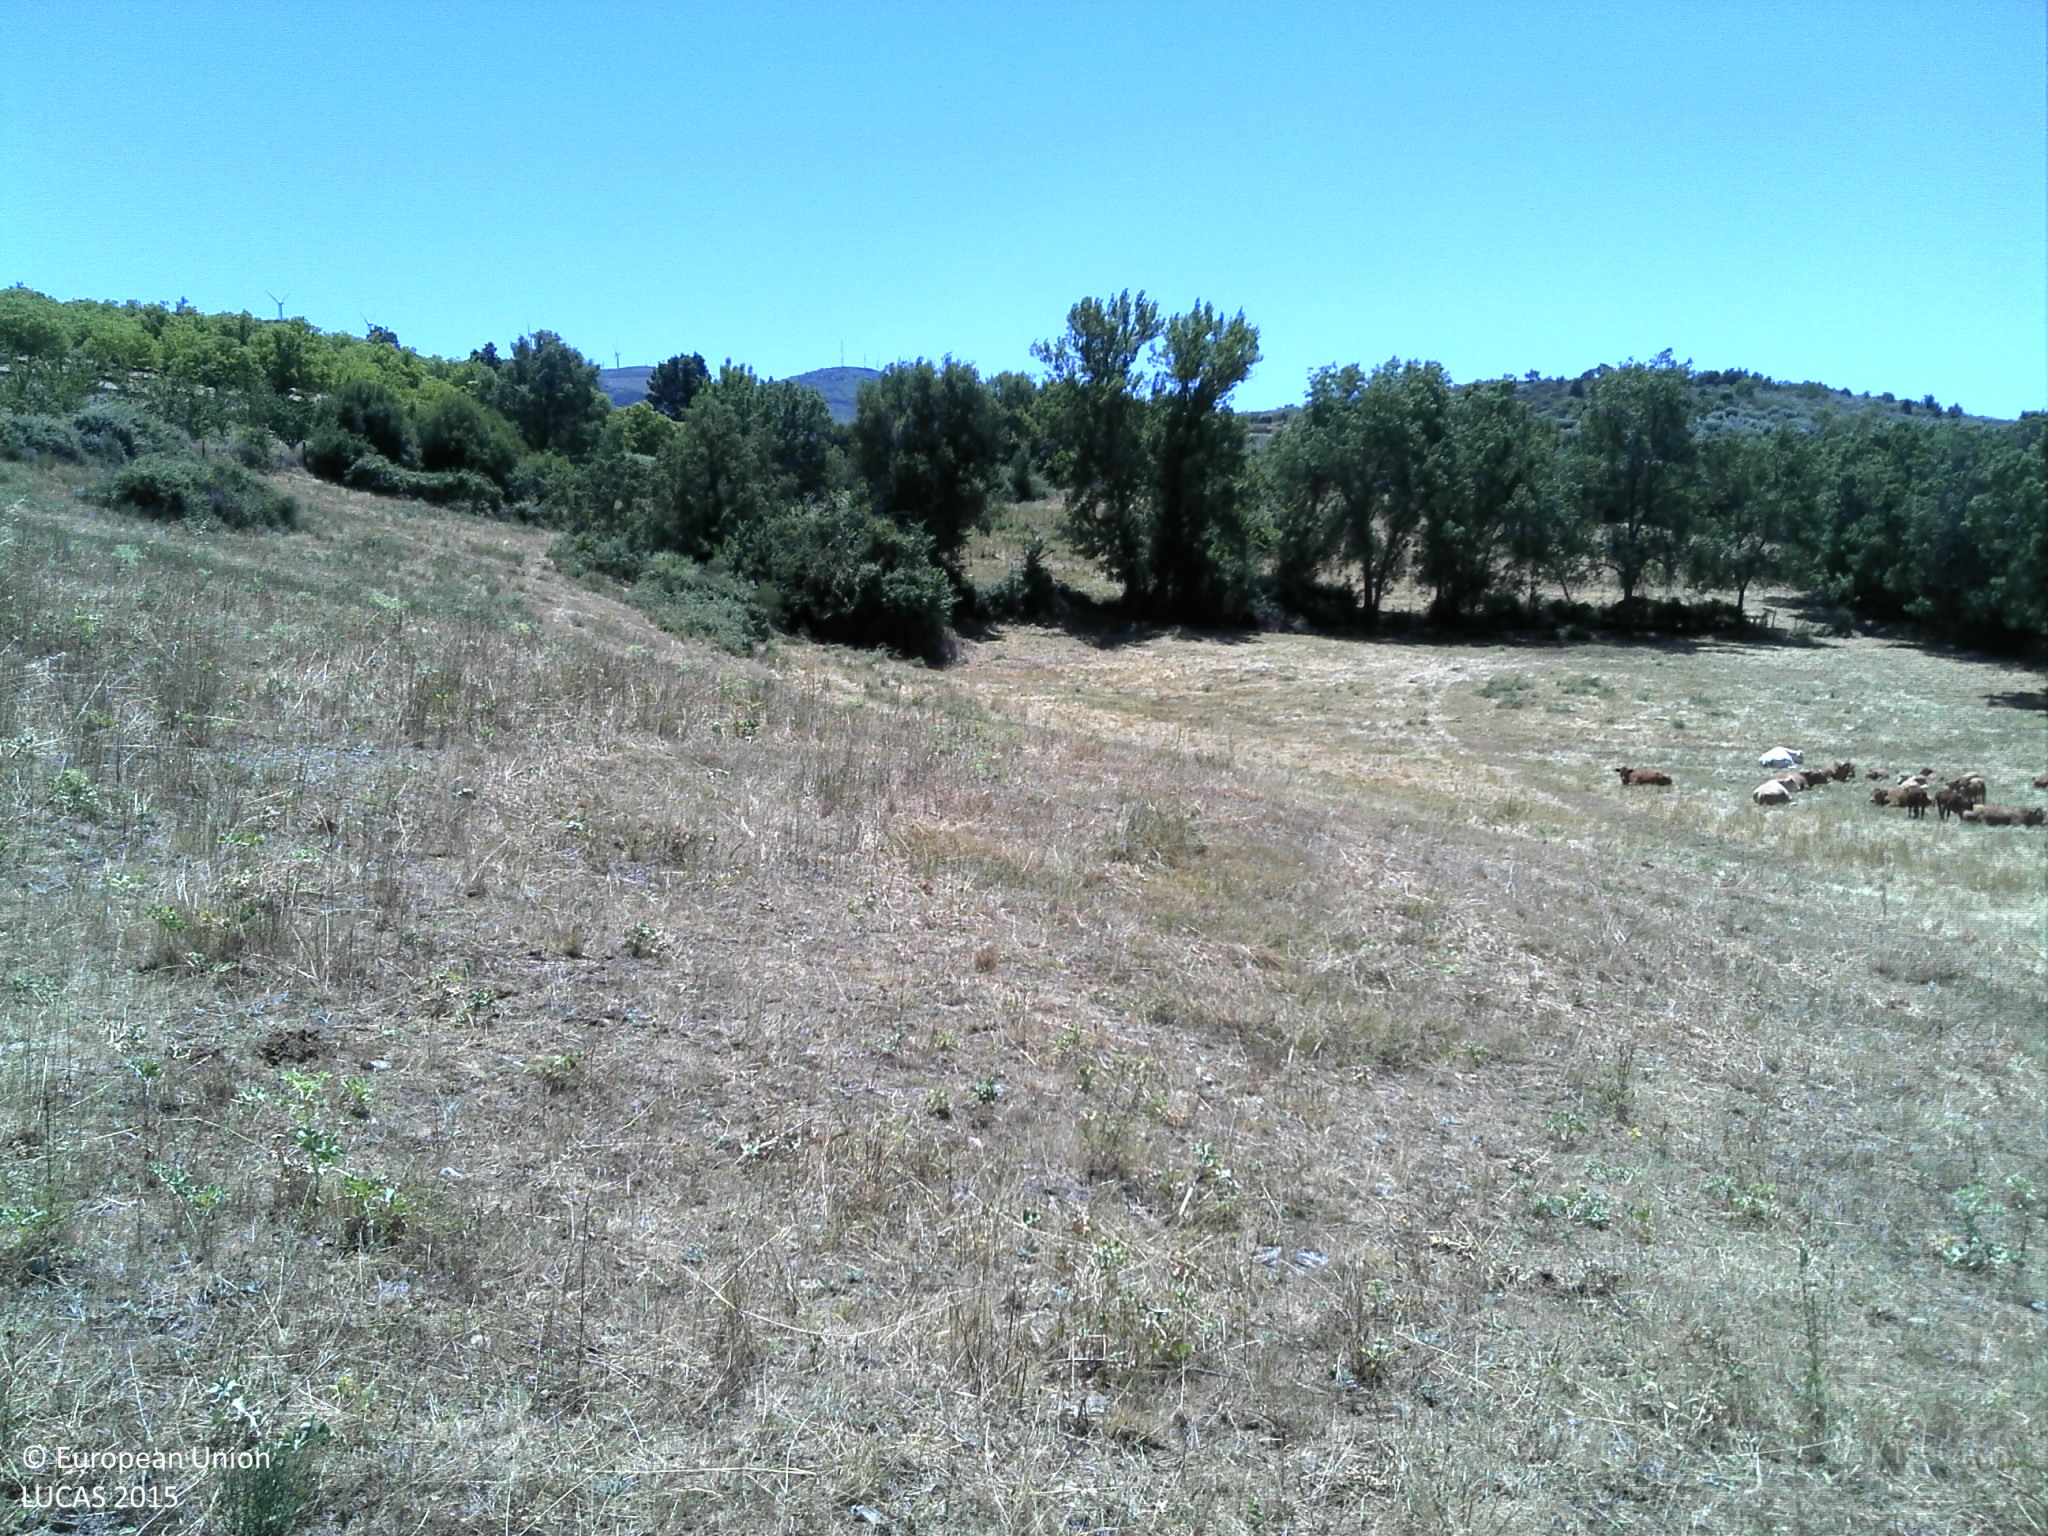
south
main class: Grassland
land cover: Grassland without tree/shrub cover
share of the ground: > 75 %
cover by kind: herbaceous plants 100 %
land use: Agriculture (excluding fallow land and kitchen gardens)
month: June
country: PT
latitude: 41.4787
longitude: -7.0120
